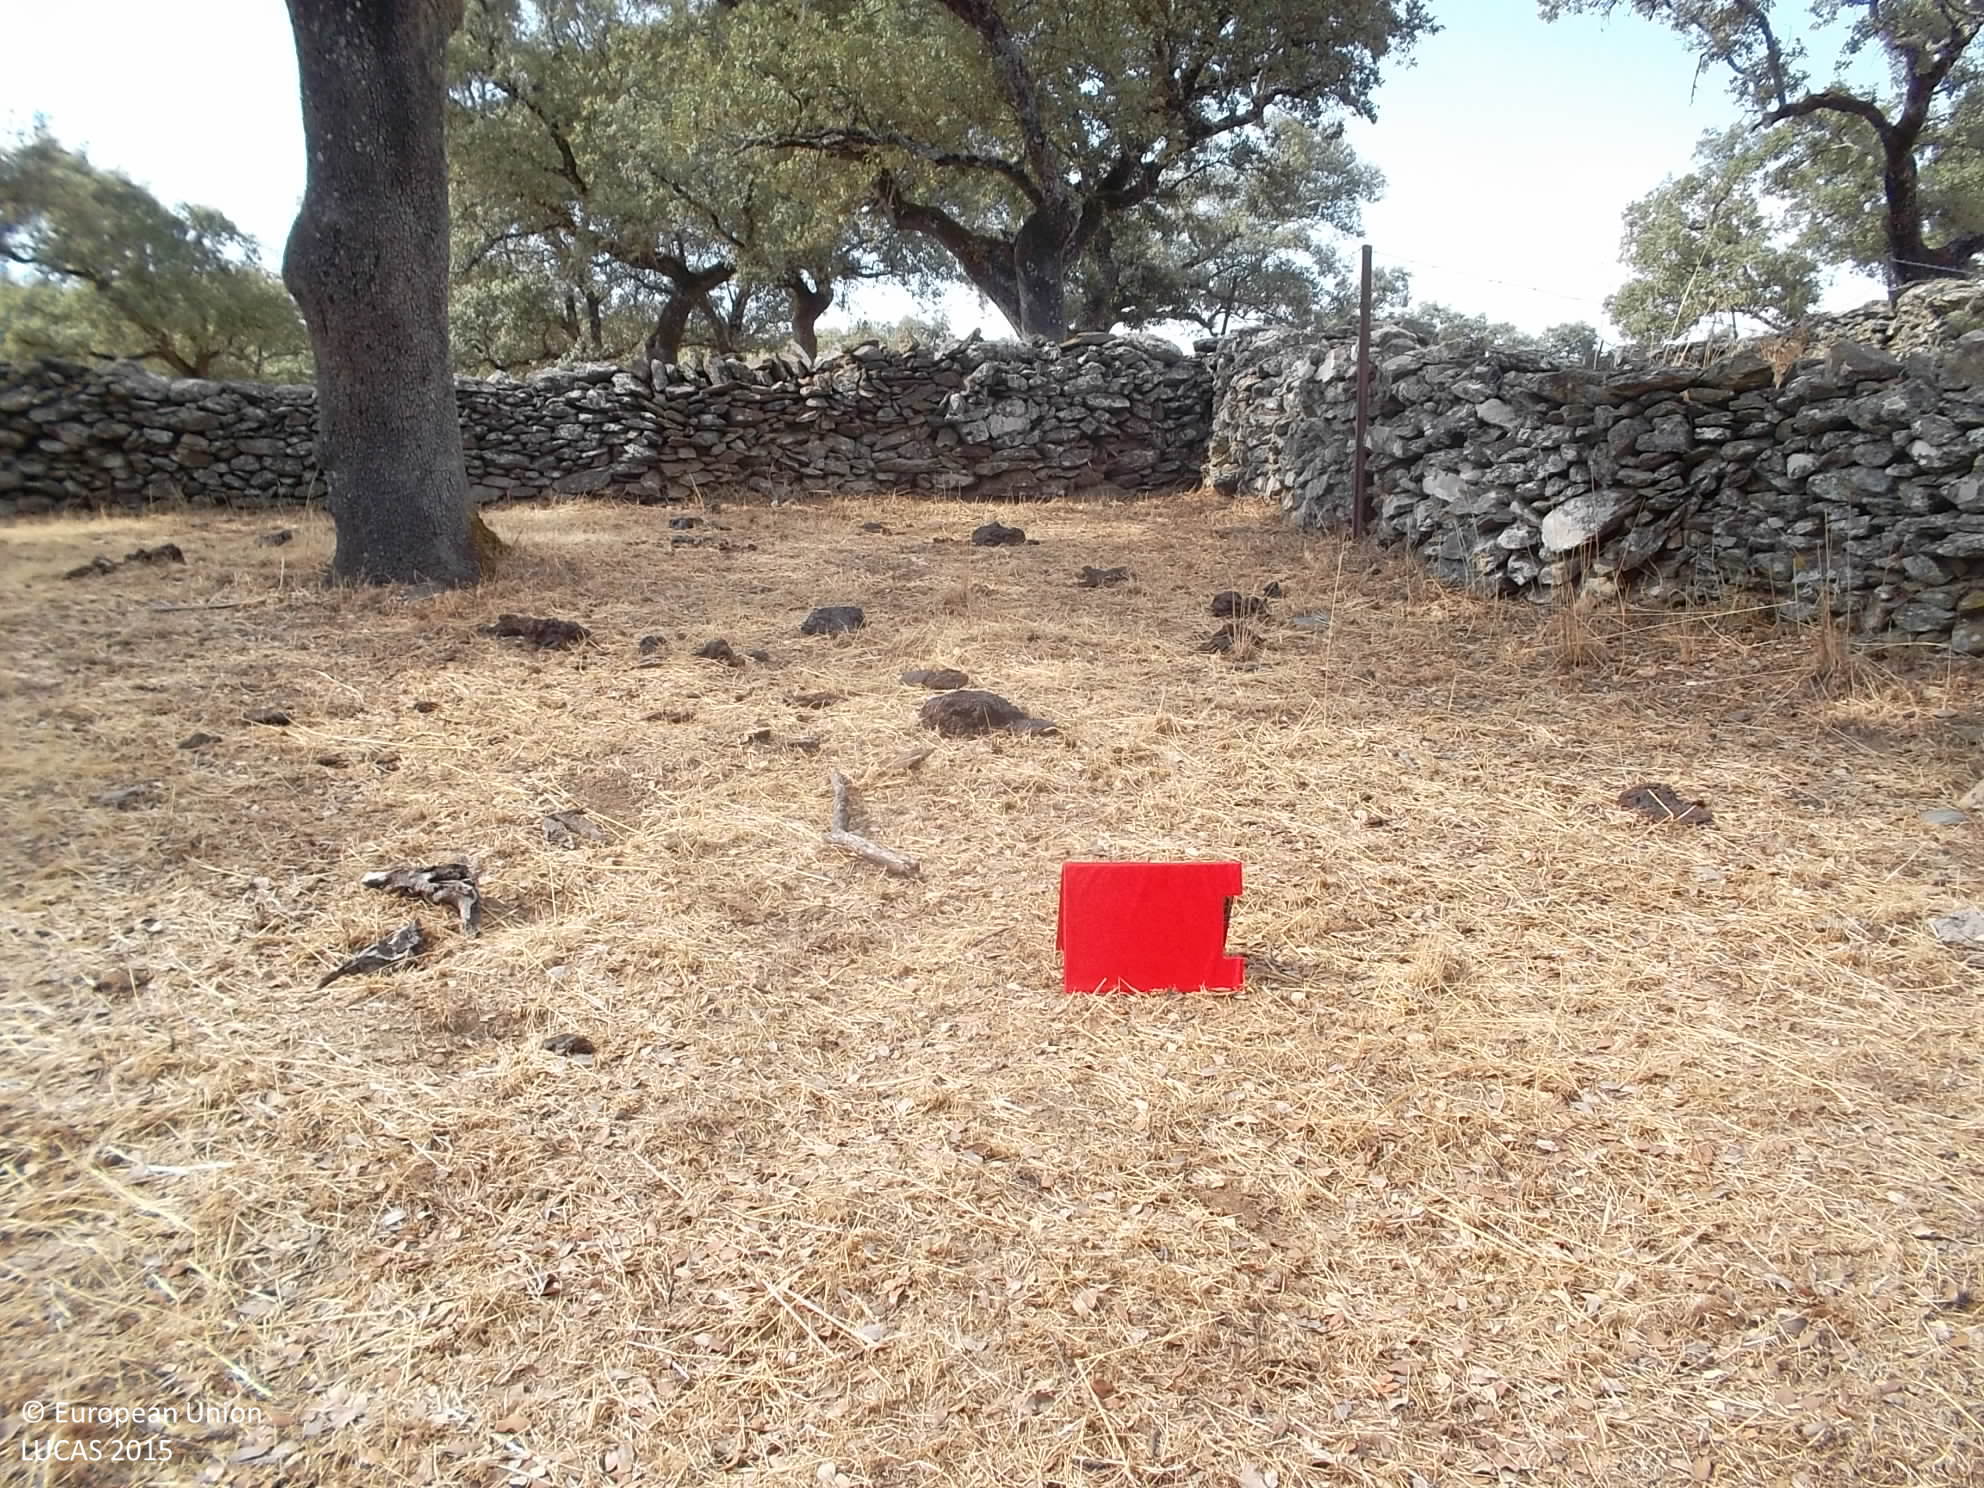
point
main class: Woodland
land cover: Broadleaved woodland
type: broadleaved evergreen forest
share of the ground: 50 - 75 %
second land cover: Grassland without tree/shrub cover
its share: > 75 %
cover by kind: broadleaved forest trees 50 %, herbaceous plants 50 %
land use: Forestry
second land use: Agriculture (excluding fallow land and kitchen gardens)
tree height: > 5 m
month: September
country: ES
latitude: 38.0503
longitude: -6.4890
